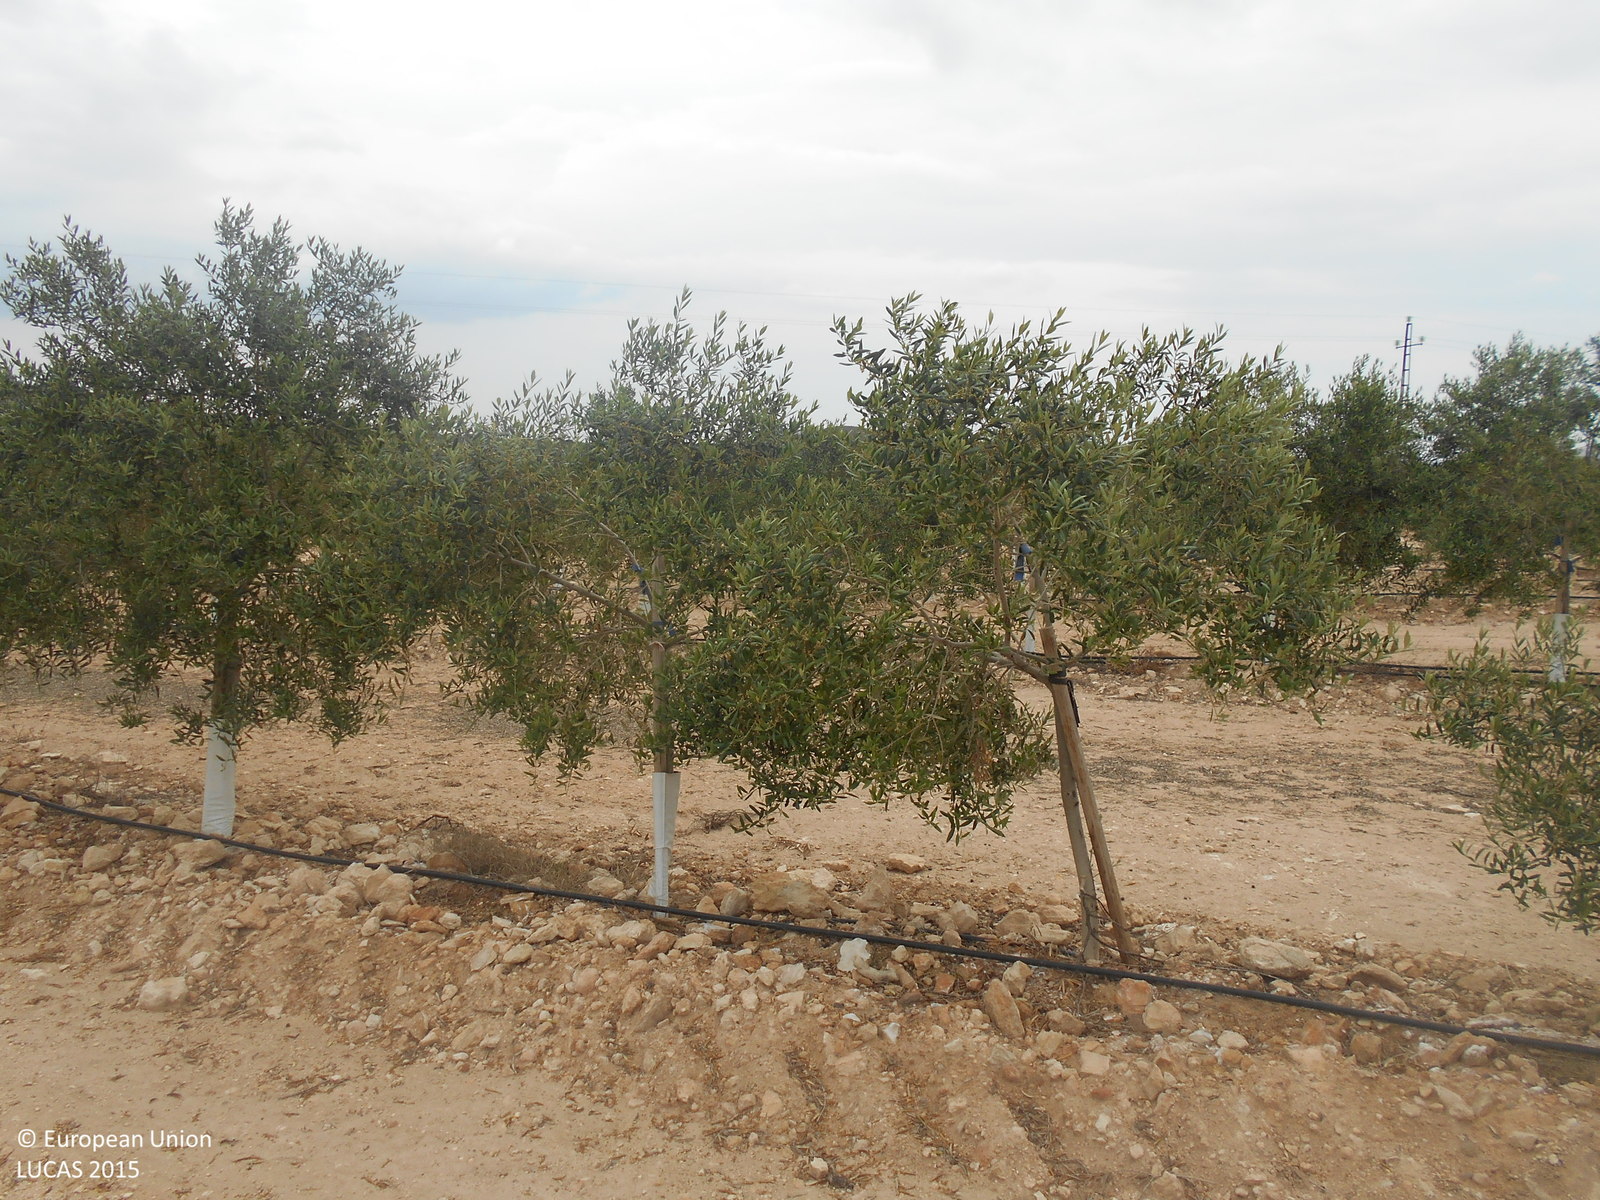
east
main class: Cropland
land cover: Olive groves
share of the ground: 10 - 25 %
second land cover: Other bare soil
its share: > 75 %
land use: Agriculture (excluding fallow land and kitchen gardens)
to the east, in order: Olive groves; Other bare soil; Tracks; Electric lines; Olive groves
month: May
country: ES
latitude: 37.0985
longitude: -2.2532
